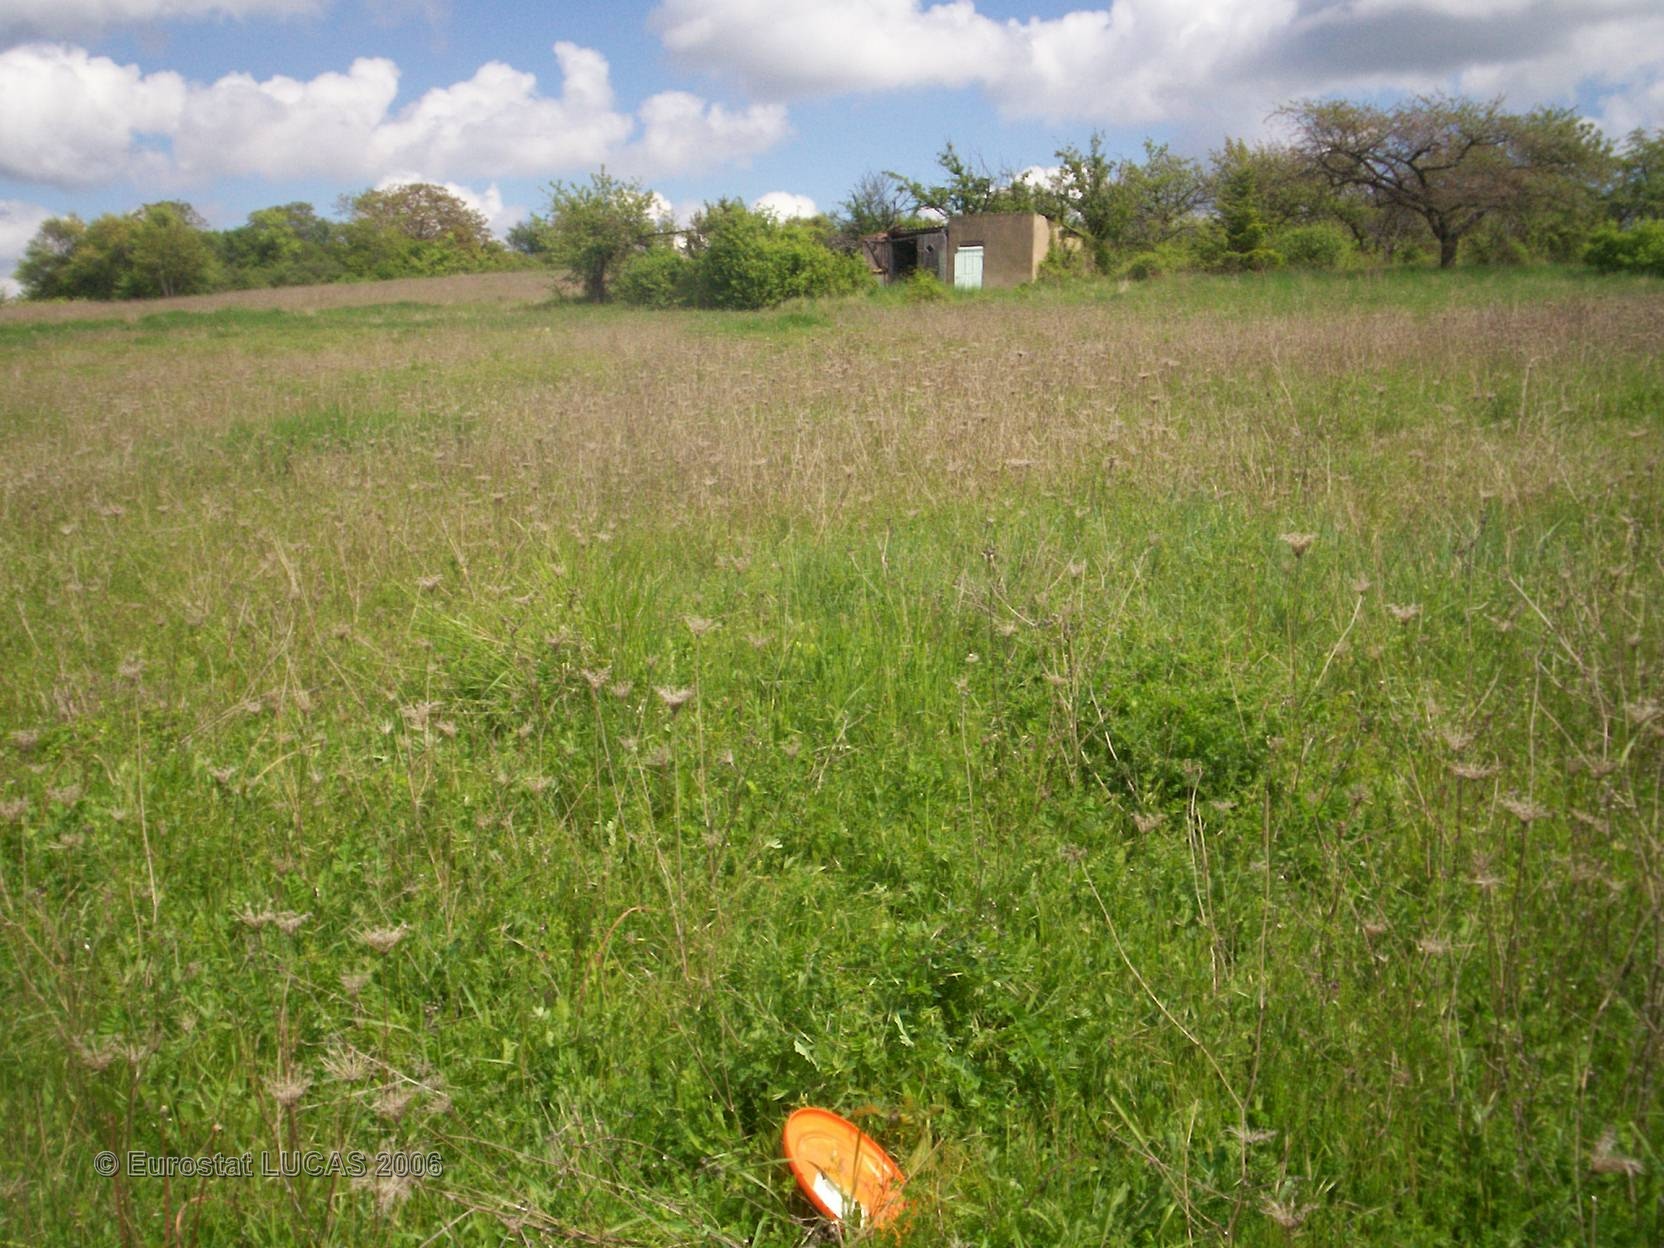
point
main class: Grassland
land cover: Grassland without tree/shrub cover
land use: Agriculture (excluding fallow land and kitchen gardens)
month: May
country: FR
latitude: 45.6996
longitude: 3.1806
